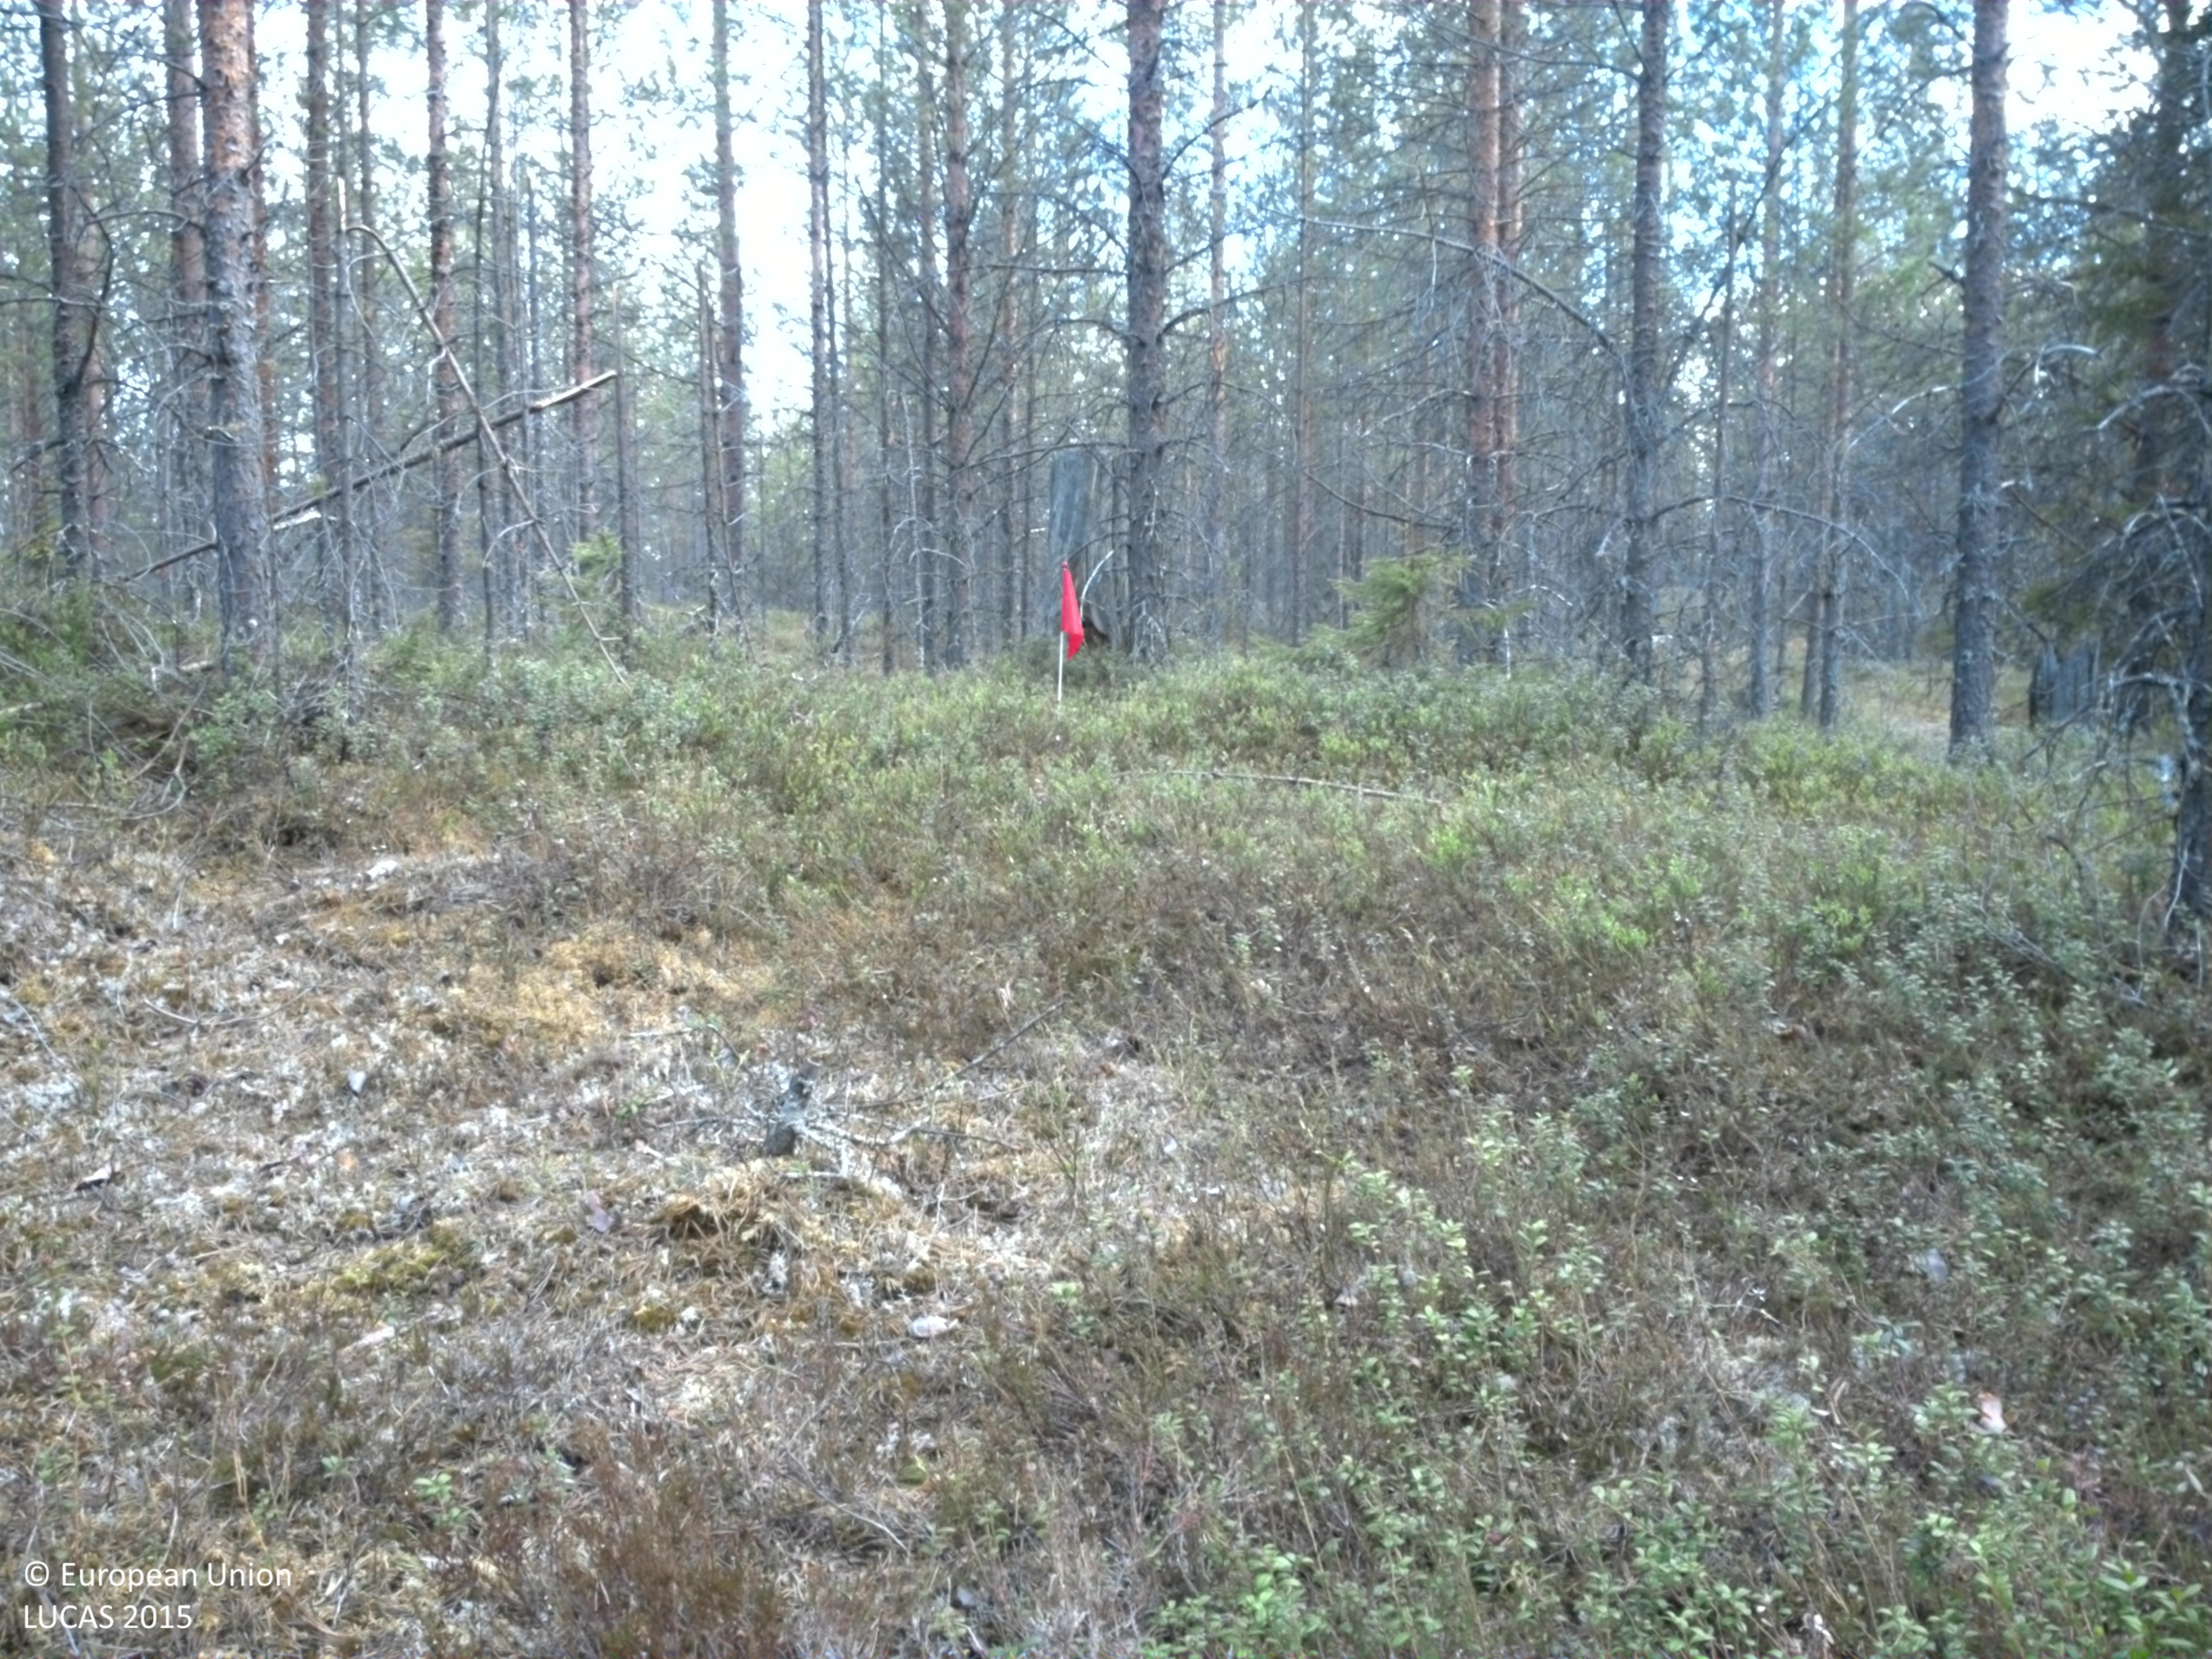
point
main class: Woodland
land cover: Pine dominated coniferous woodland
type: boreal forest
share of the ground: 50 - 75 %
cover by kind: coniferous forest trees 50 %, shrubs 45 %, consolidated bare surface 5 %
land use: Forestry
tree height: > 5 m
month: June
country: SE
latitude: 65.9752
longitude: 19.4448
